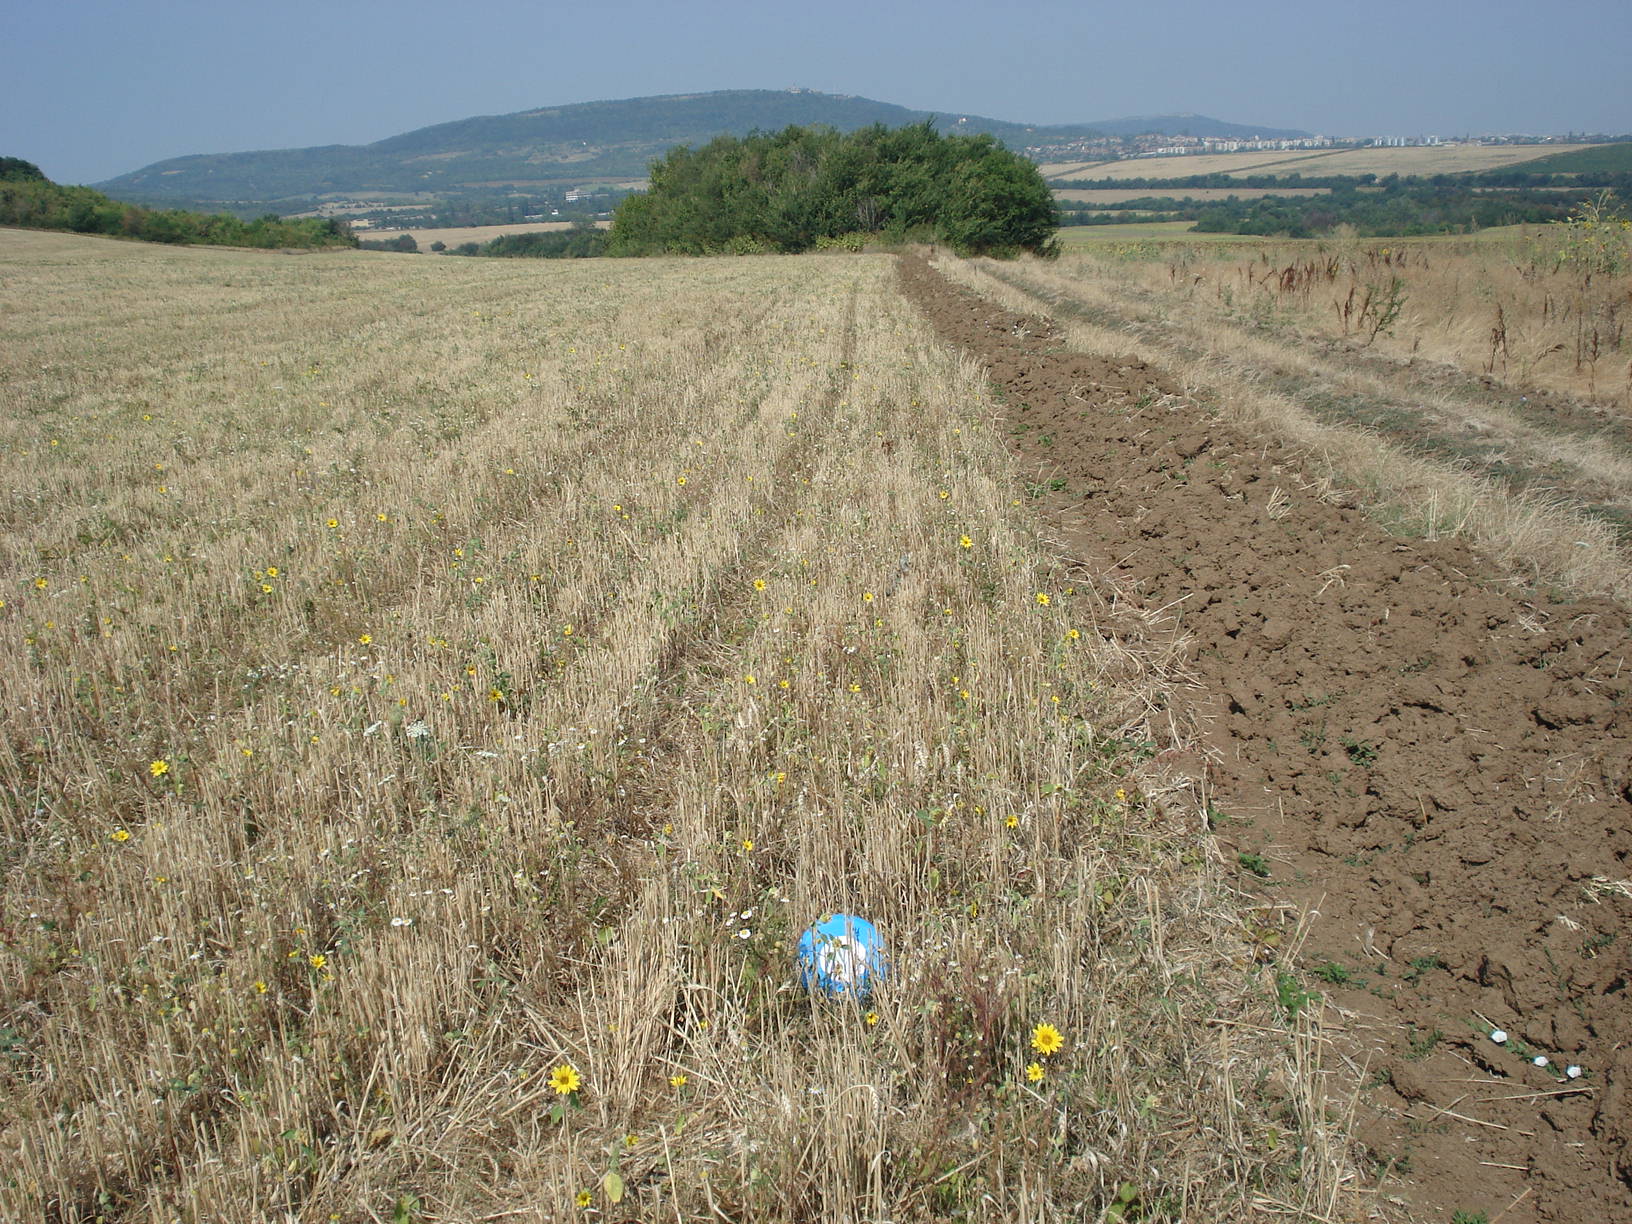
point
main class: Cropland
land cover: Common wheat
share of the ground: 50 - 75 %
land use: Agriculture (excluding fallow land and kitchen gardens)
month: August
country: BG
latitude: 43.0808
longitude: 25.7679
